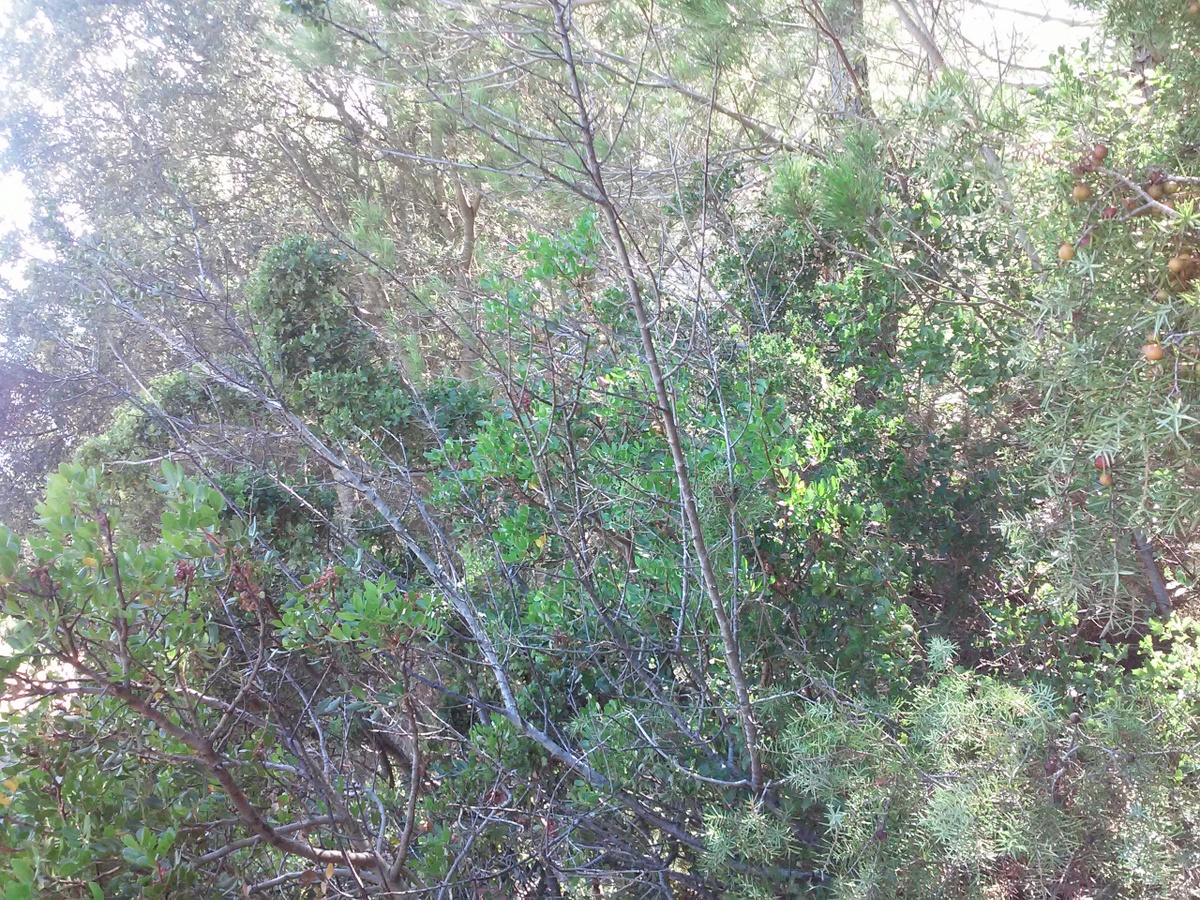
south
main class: Woodland
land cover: Pine dominated coniferous woodland
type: coniferous forest of the mediterranean region
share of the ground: > 75 %
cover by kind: coniferous forest trees 80 %, shrubs 20 %
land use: Semi-natural and natural areas not in use
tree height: > 5 m
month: August
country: ES
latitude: 41.0549
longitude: 0.8193
